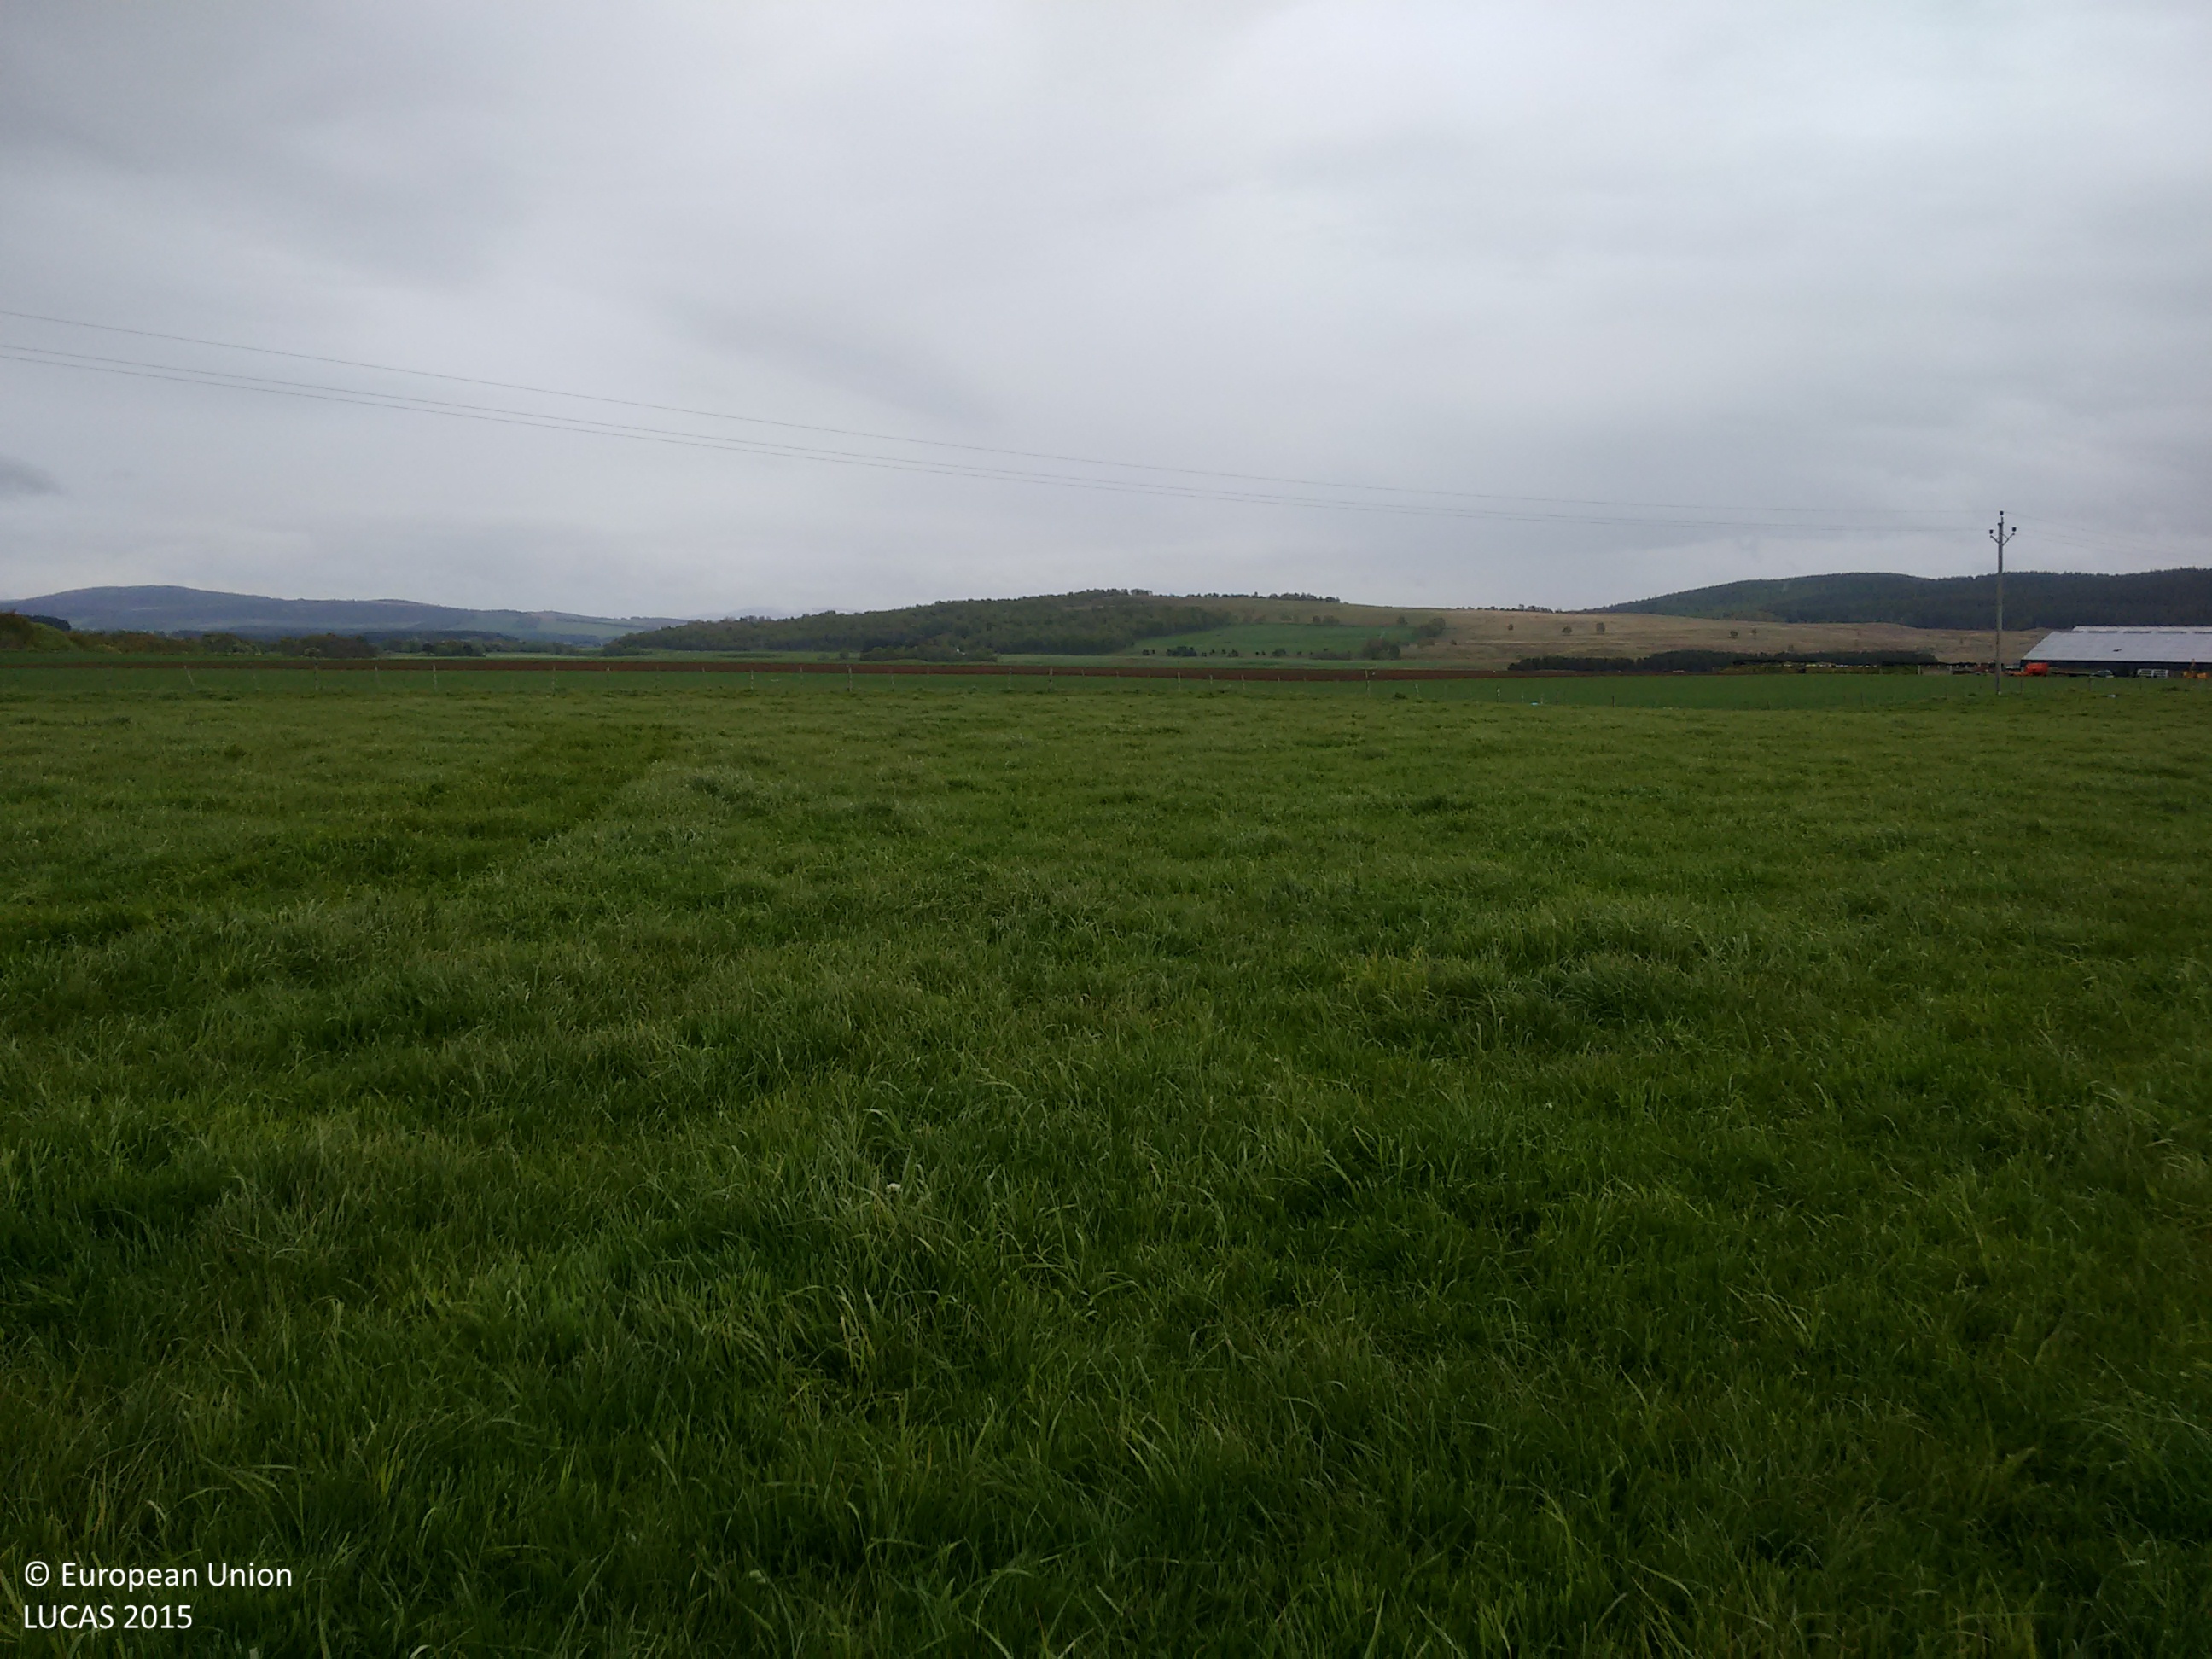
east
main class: Grassland
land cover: Grassland without tree/shrub cover
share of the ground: > 75 %
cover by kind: herbaceous plants 100 %
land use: Agriculture (excluding fallow land and kitchen gardens)
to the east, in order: Grassland without tree/shrub cover; Fences; Electric lines; Barley; Other bare soil; Barley
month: June
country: GB
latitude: 57.2837
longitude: -3.7965
